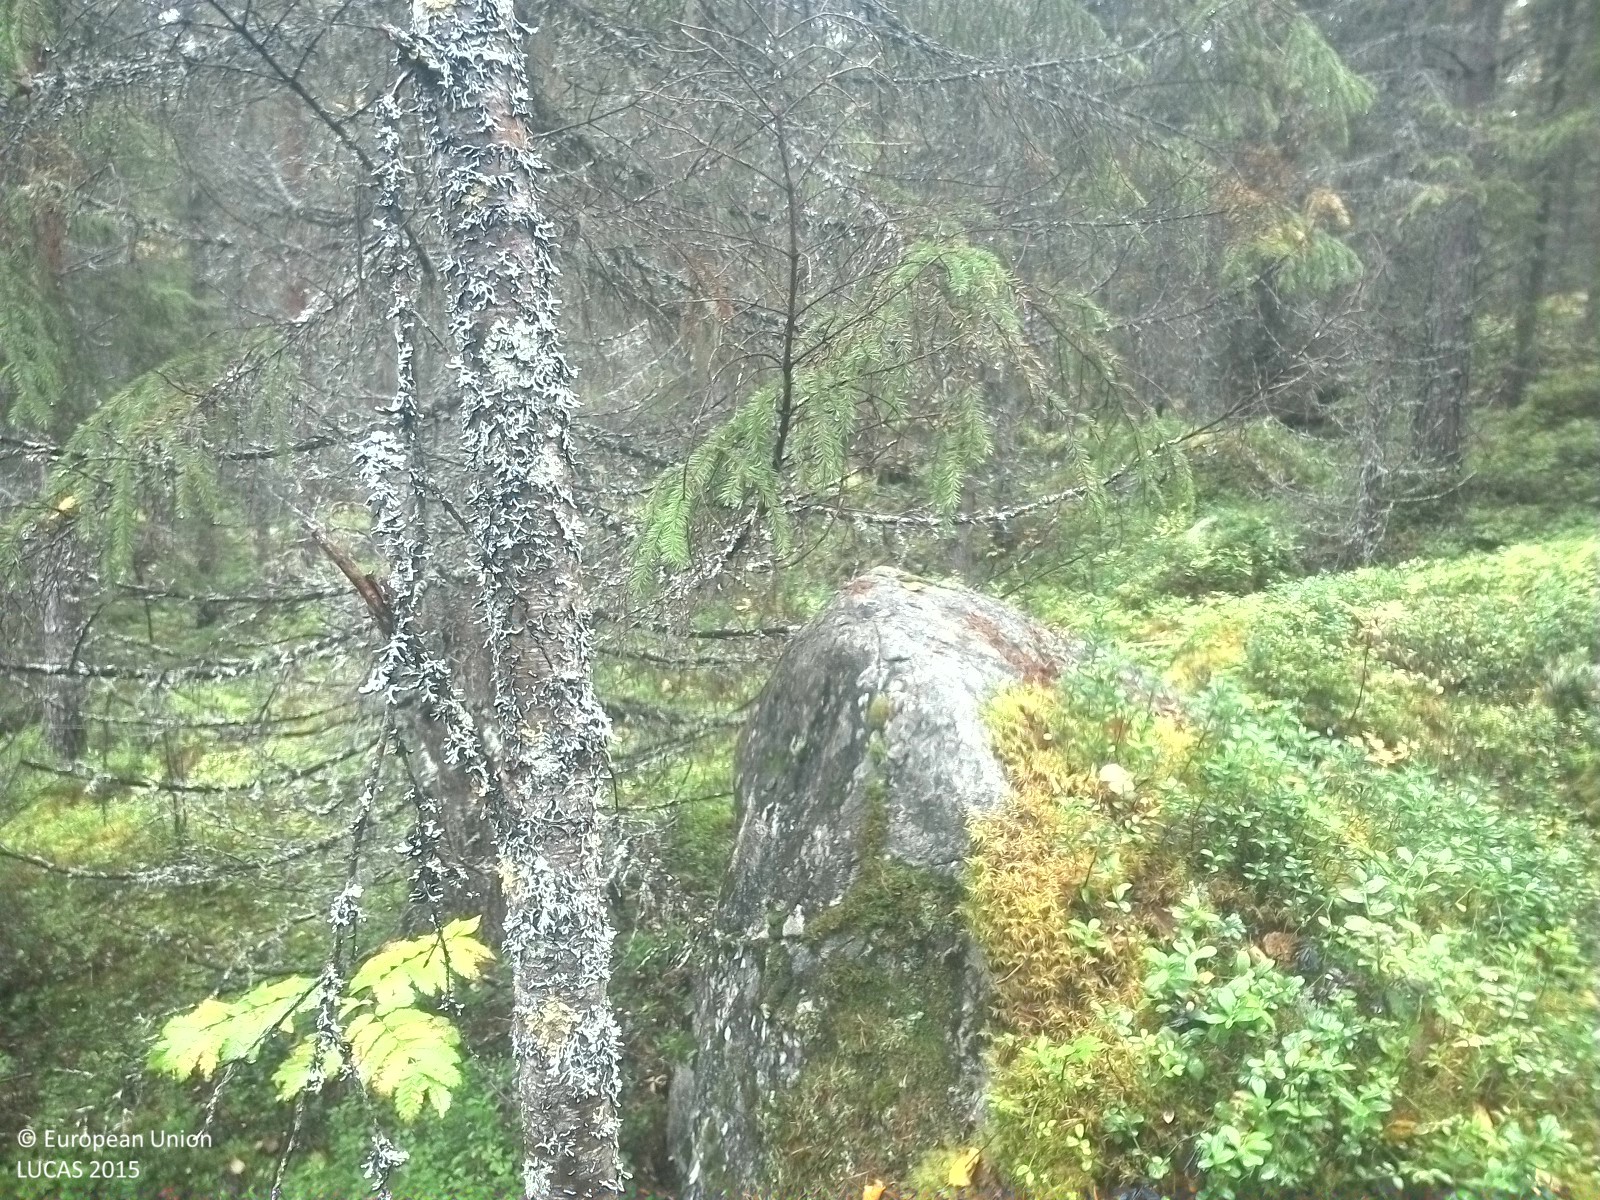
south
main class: Woodland
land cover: Spruce dominated mixed woodland
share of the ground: 50 - 75 %
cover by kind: broadleaved forest trees 40 %, shrubs 40 %, coniferous forest trees 15 %, lichens and mosses 5 %
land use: Forestry
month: September
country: SE
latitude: 62.2722
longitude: 15.6255
